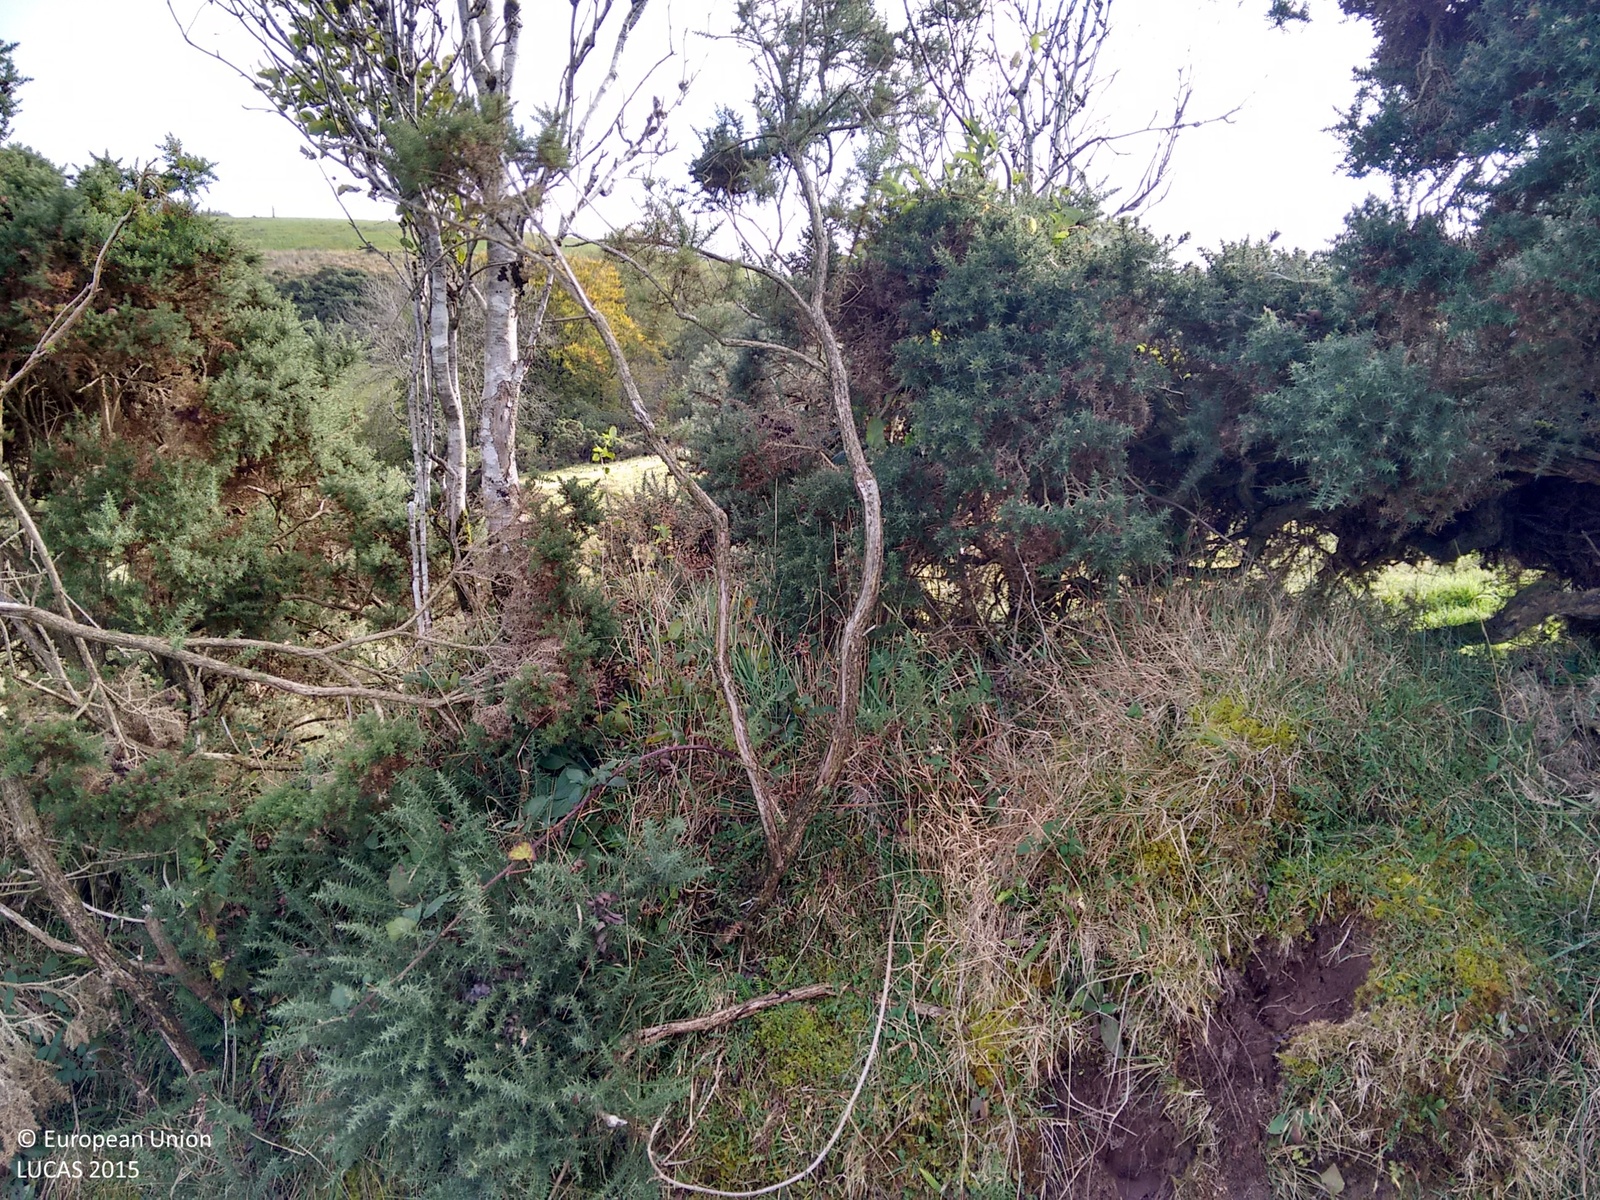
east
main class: Grassland
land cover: Grassland without tree/shrub cover
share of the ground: > 75 %
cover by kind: herbaceous plants 100 %
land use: Agriculture (excluding fallow land and kitchen gardens)
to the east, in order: Ditches and canals; Abandoned hedges; Grassland without tree/shrub cover; Ditches and canals; Abandoned hedges; Fences; Grassland without tree/shrub cover; Fences; Broadleaved woodland; Ditches and canals; Broadleaved woodland; Grassland without tree/shrub cover; Fences; Grass margins; Tracks; Grass margins; Abandoned hedges; Shrubland without tree cover; Grassland without tree/shrub cover; Tracks; Fences; Abandoned hedges; Grassland without tree/shrub cover
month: October
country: GB
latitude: 54.4526
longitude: -7.3800
